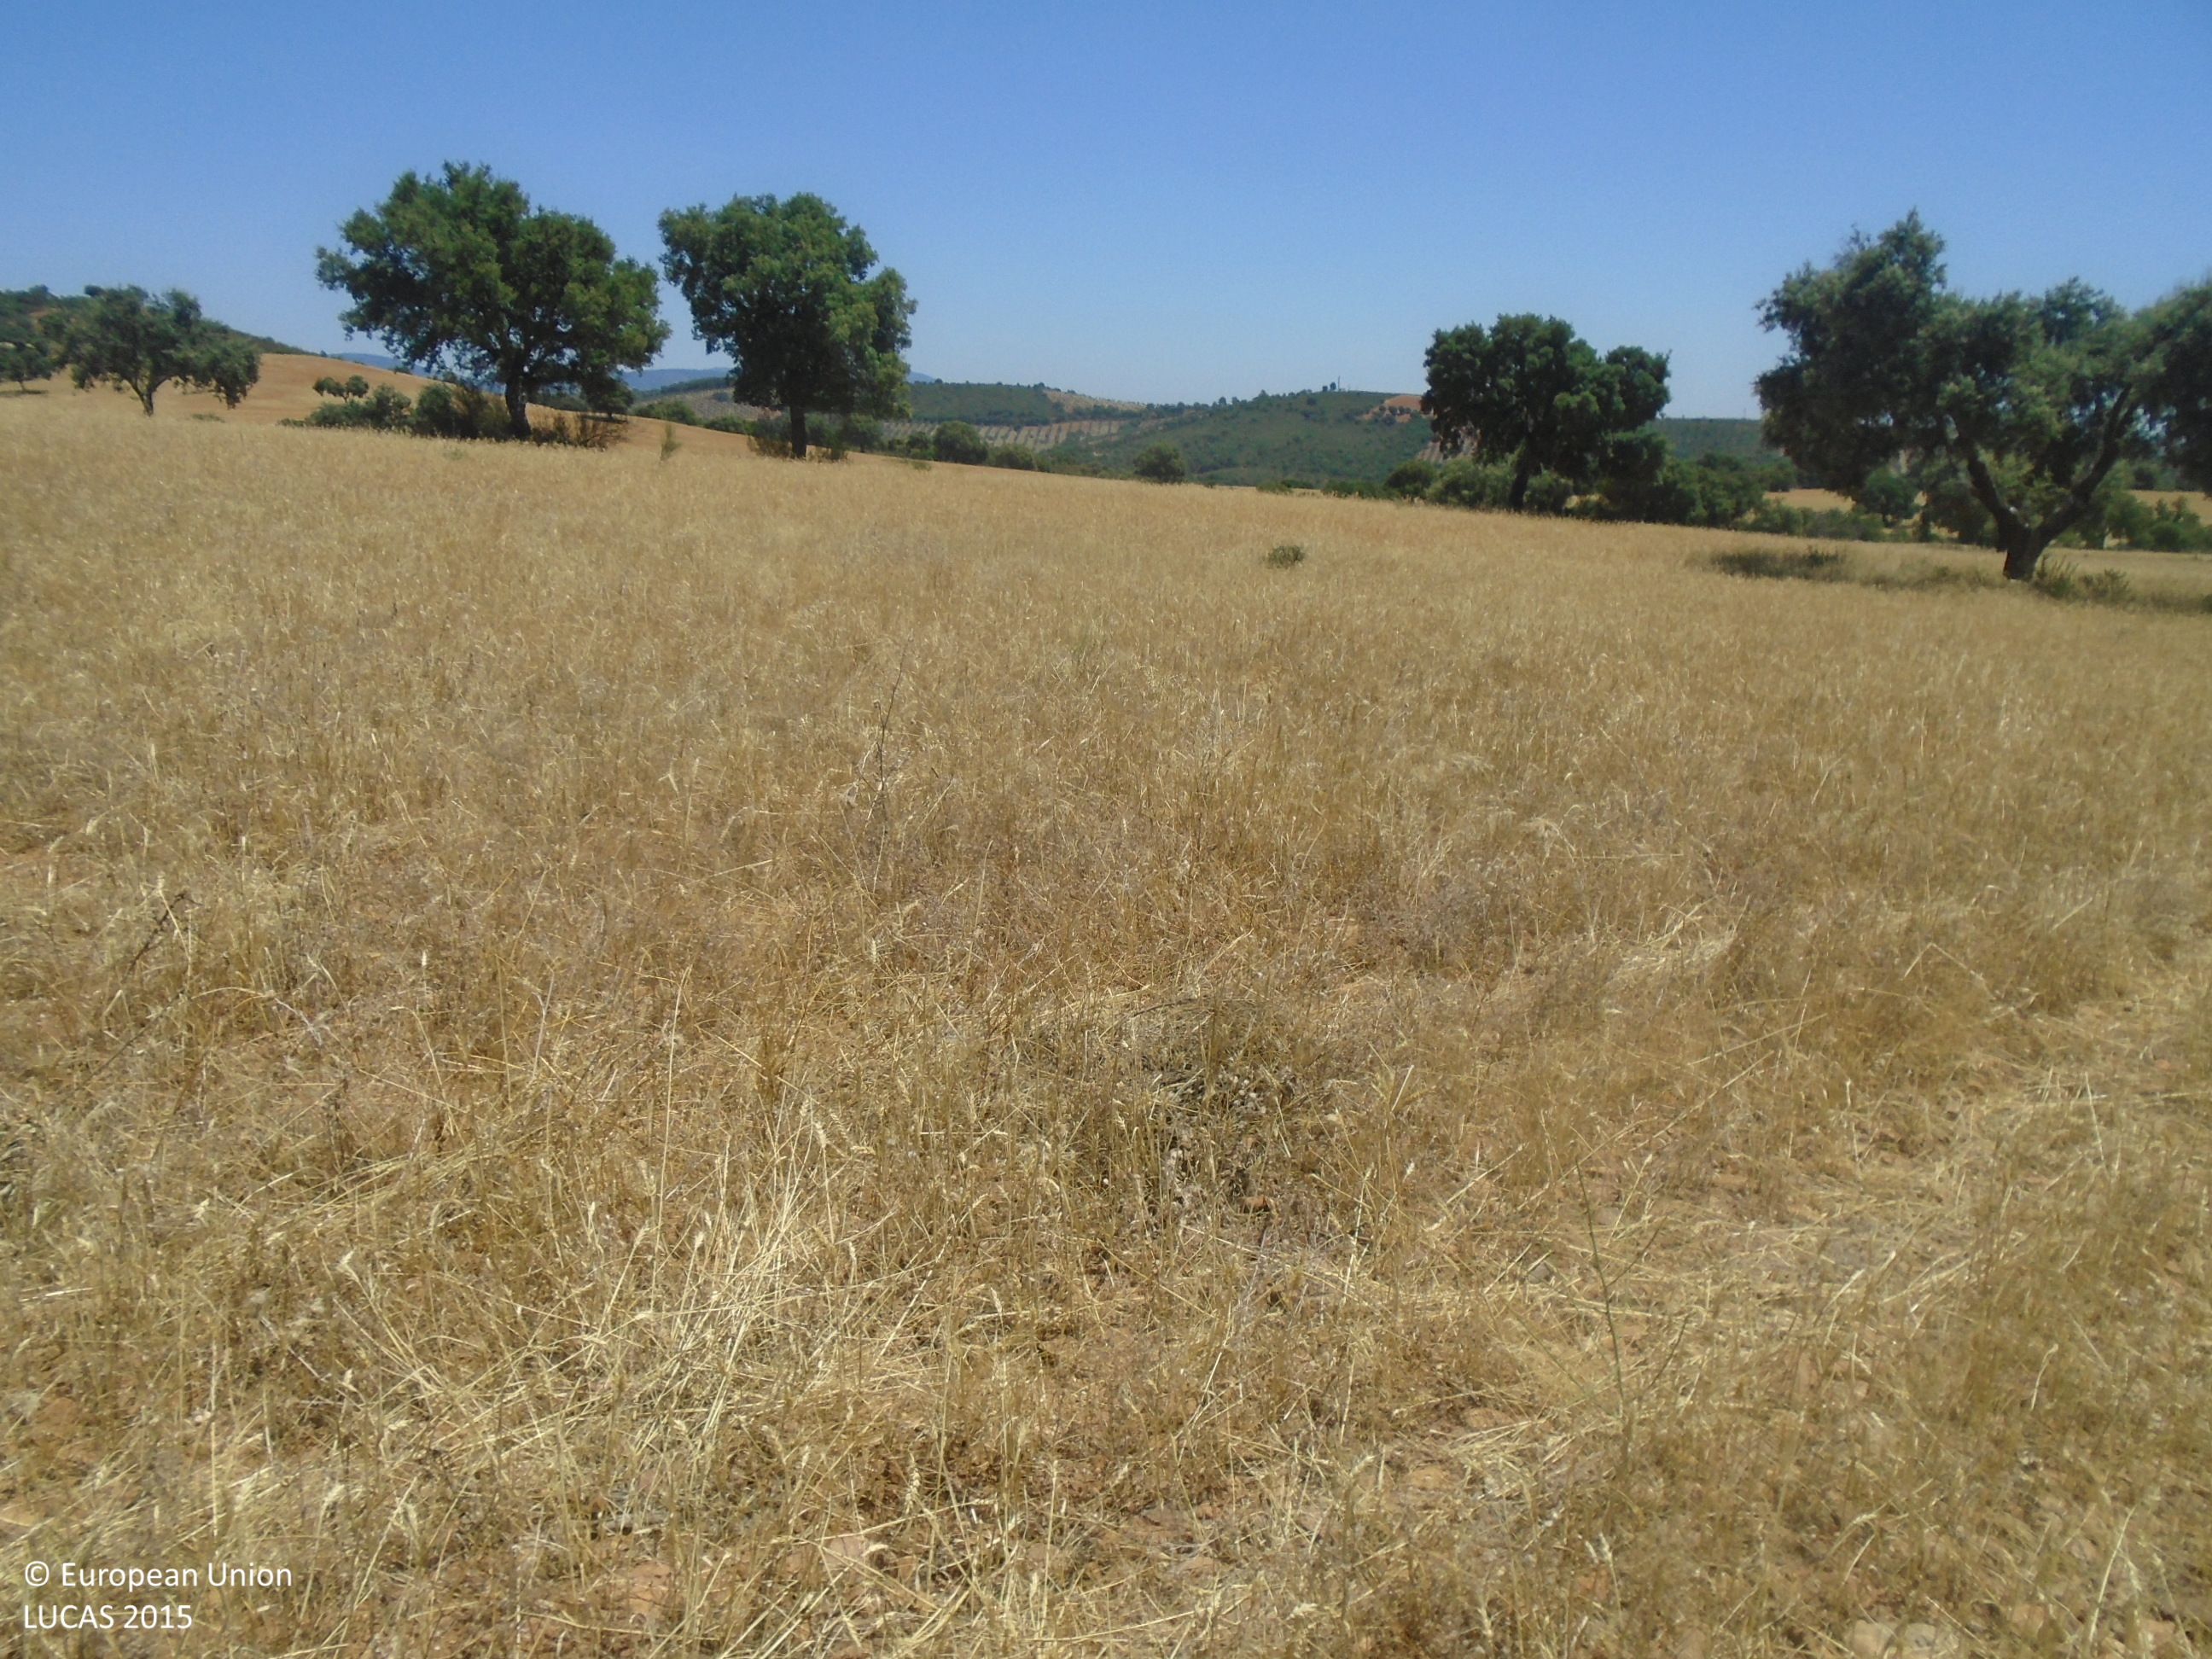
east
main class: Cropland
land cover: Mixed cereals for fodder
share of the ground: > 75 %
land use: Agriculture (excluding fallow land and kitchen gardens)
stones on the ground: > 50 %
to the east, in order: Mixed cereals for fodder; Single bushes/trees; Mixed cereals for fodder; Single bushes/trees; Mixed cereals for fodder; Tracks; Mixed cereals for fodder; Grassland with sparse tree/shrub cover; Ditches and canals; Grassland with sparse tree/shrub cover
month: July
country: ES
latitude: 39.4593
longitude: -4.8590
